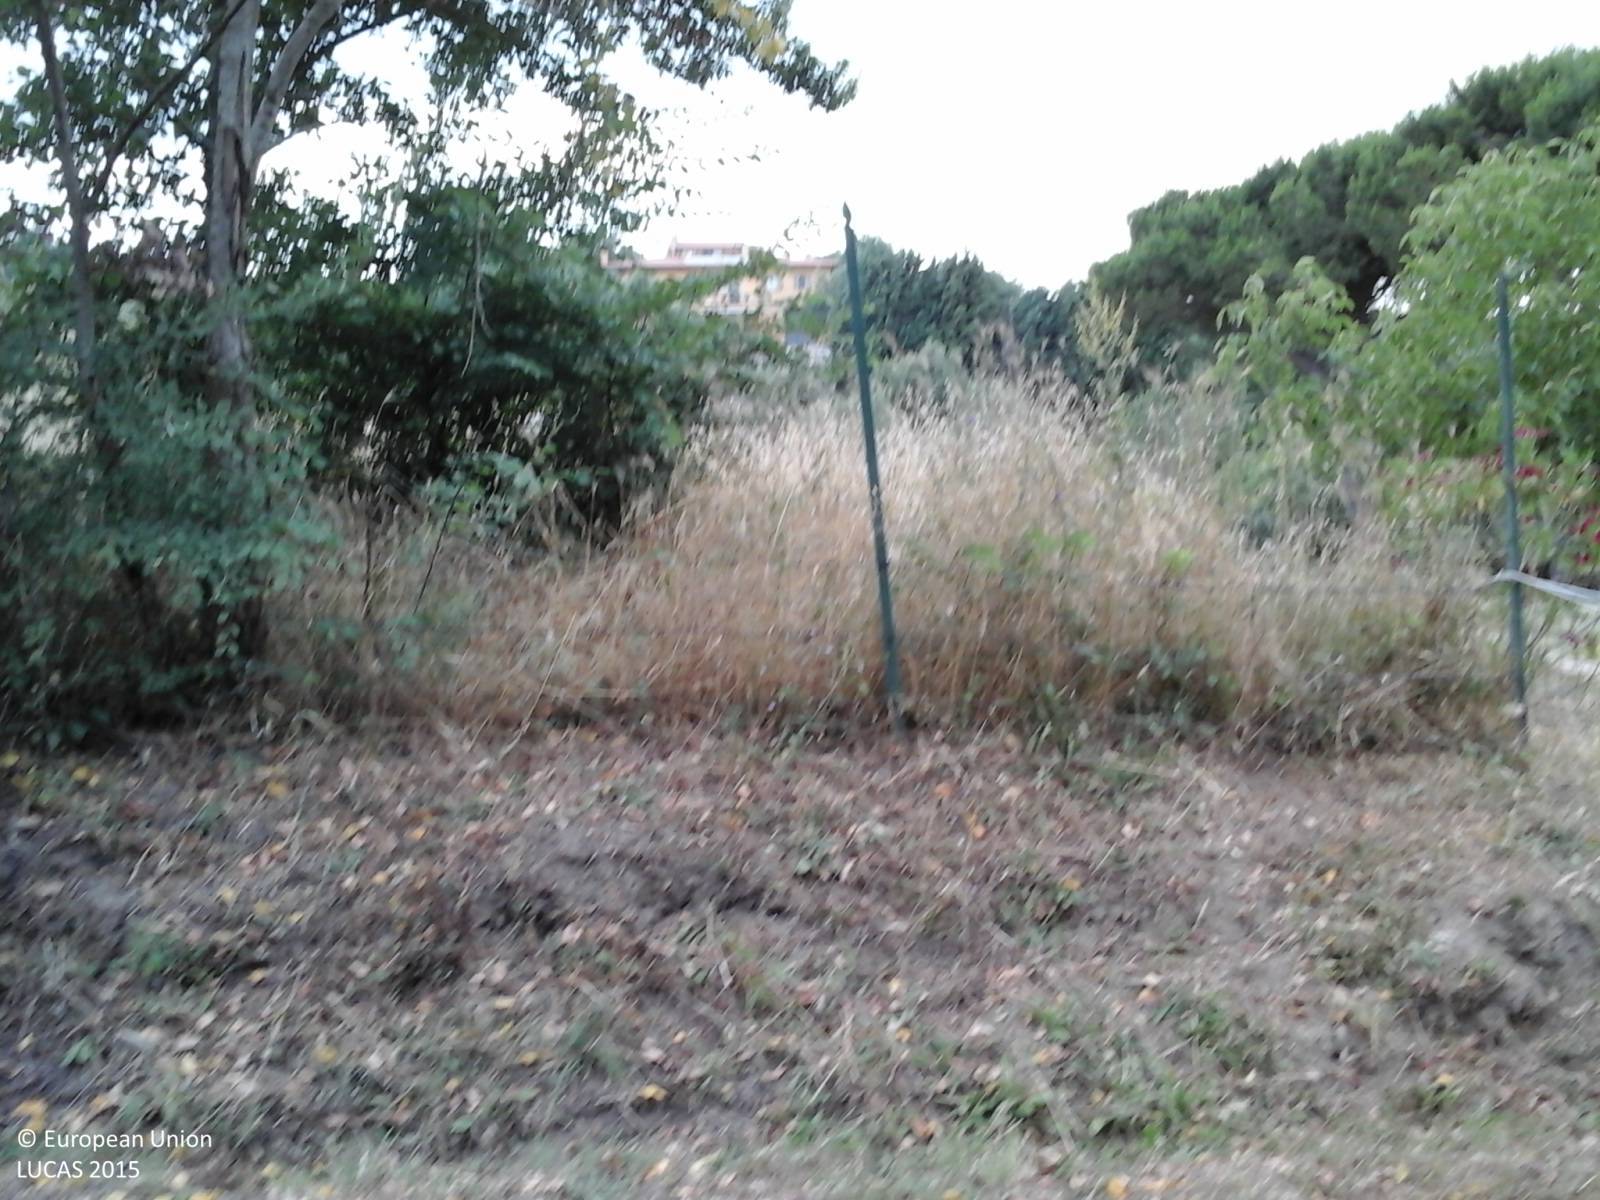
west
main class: Woodland
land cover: Broadleaved woodland
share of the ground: 50 - 75 %
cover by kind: herbaceous plants 60 %, broadleaved forest trees 15 %, unconsolidated bare surface 15 %, coniferous forest trees 5 %, shrubs 5 %
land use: Residential
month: June
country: IT
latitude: 42.1388
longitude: 12.3509
